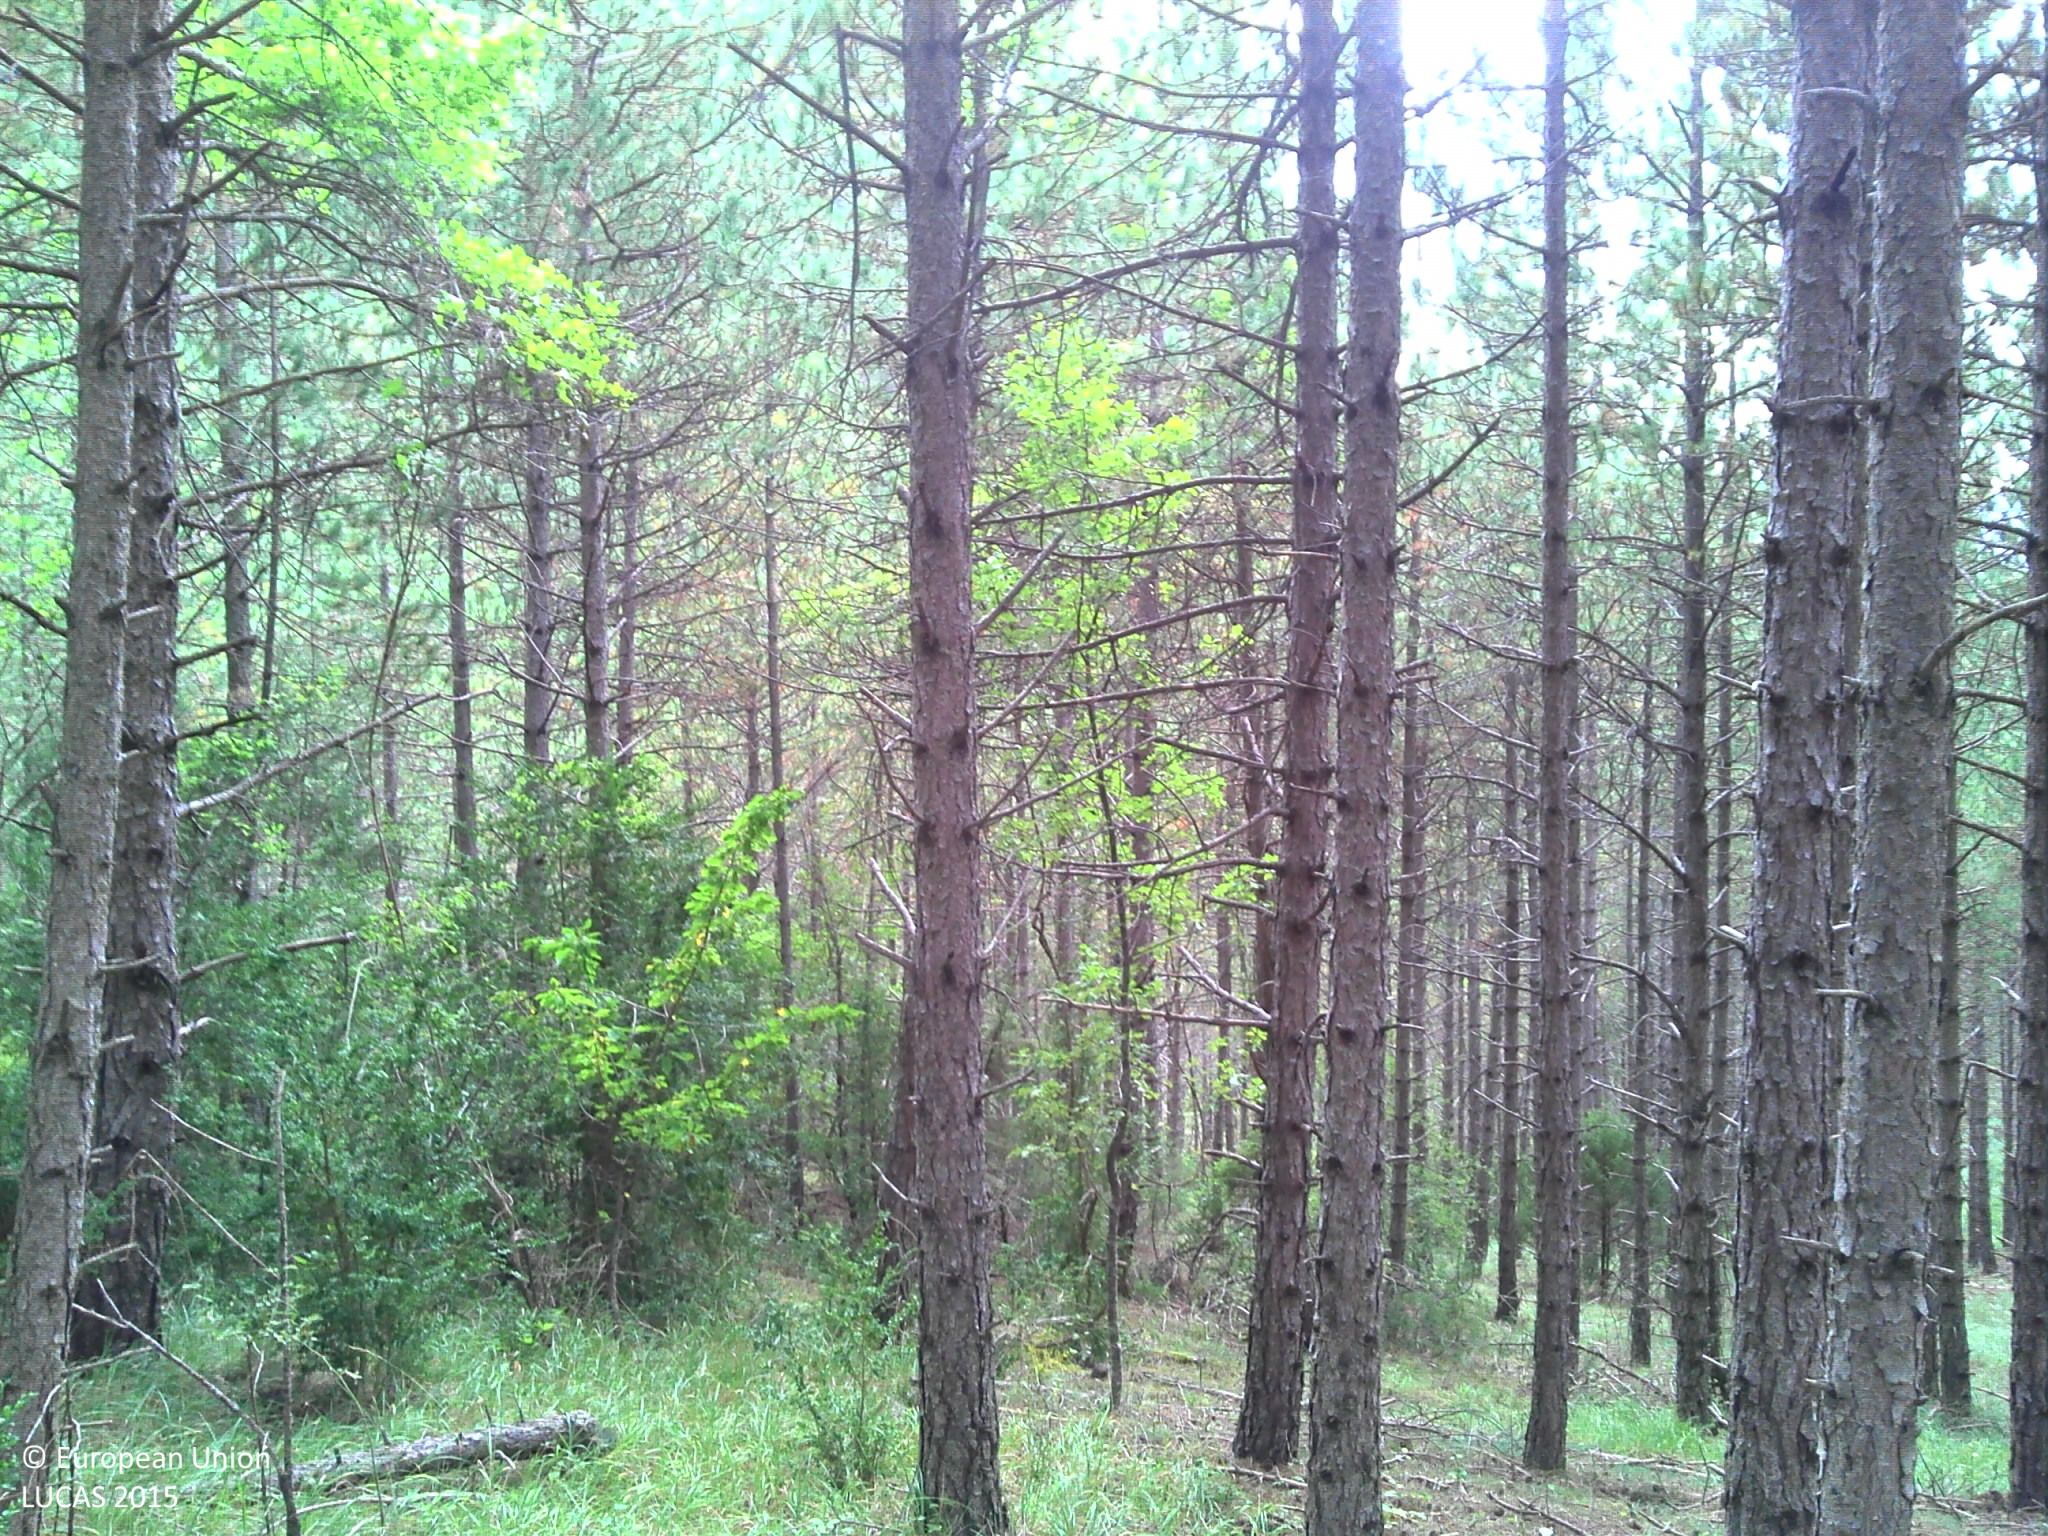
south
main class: Woodland
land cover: Pine dominated coniferous woodland
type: exotic forest
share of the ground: > 75 %
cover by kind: coniferous forest trees 80 %, herbaceous plants 15 %, shrubs 5 %
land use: Forestry
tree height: > 5 m
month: September
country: FR
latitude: 44.4716
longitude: 5.5444
